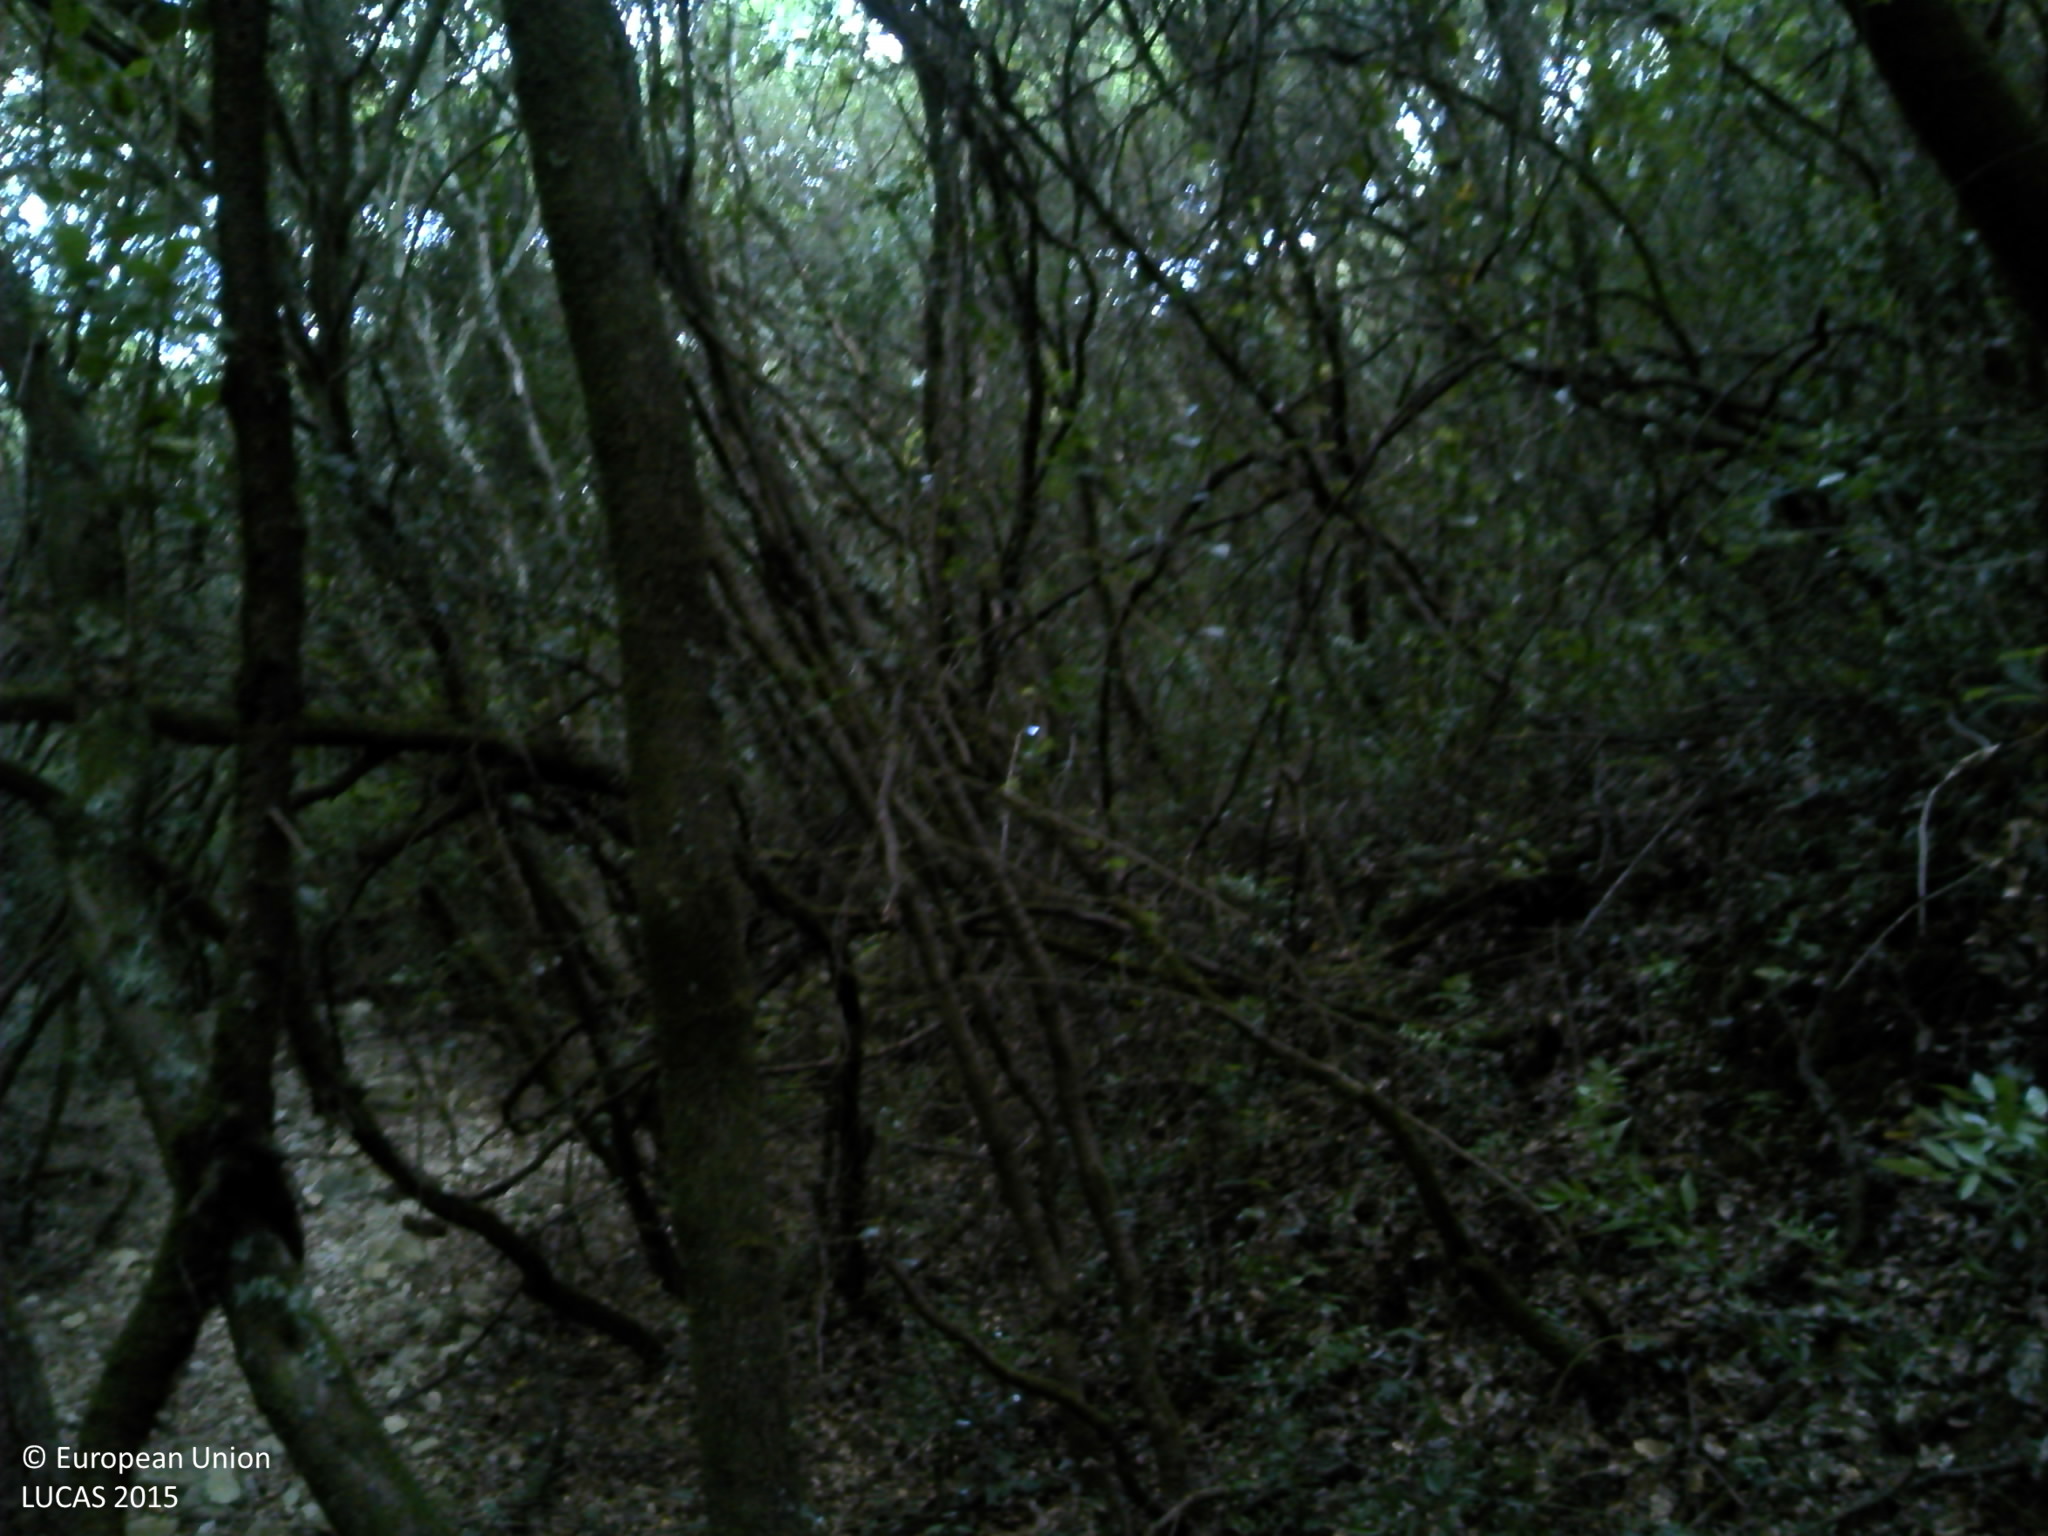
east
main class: Woodland
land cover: Broadleaved woodland
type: thermophilous deciduous forest
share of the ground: > 75 %
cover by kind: broadleaved forest trees 75 %, shrubs 25 %
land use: Semi-natural and natural areas not in use
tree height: < 5 m
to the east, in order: Broadleaved woodland; Tracks; Broadleaved woodland; Shrubland with sparse tree cover; Tracks; Shrubland without tree cover; Tracks; Shrubland without tree cover
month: June
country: PT
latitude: 39.0838
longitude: -9.2411
